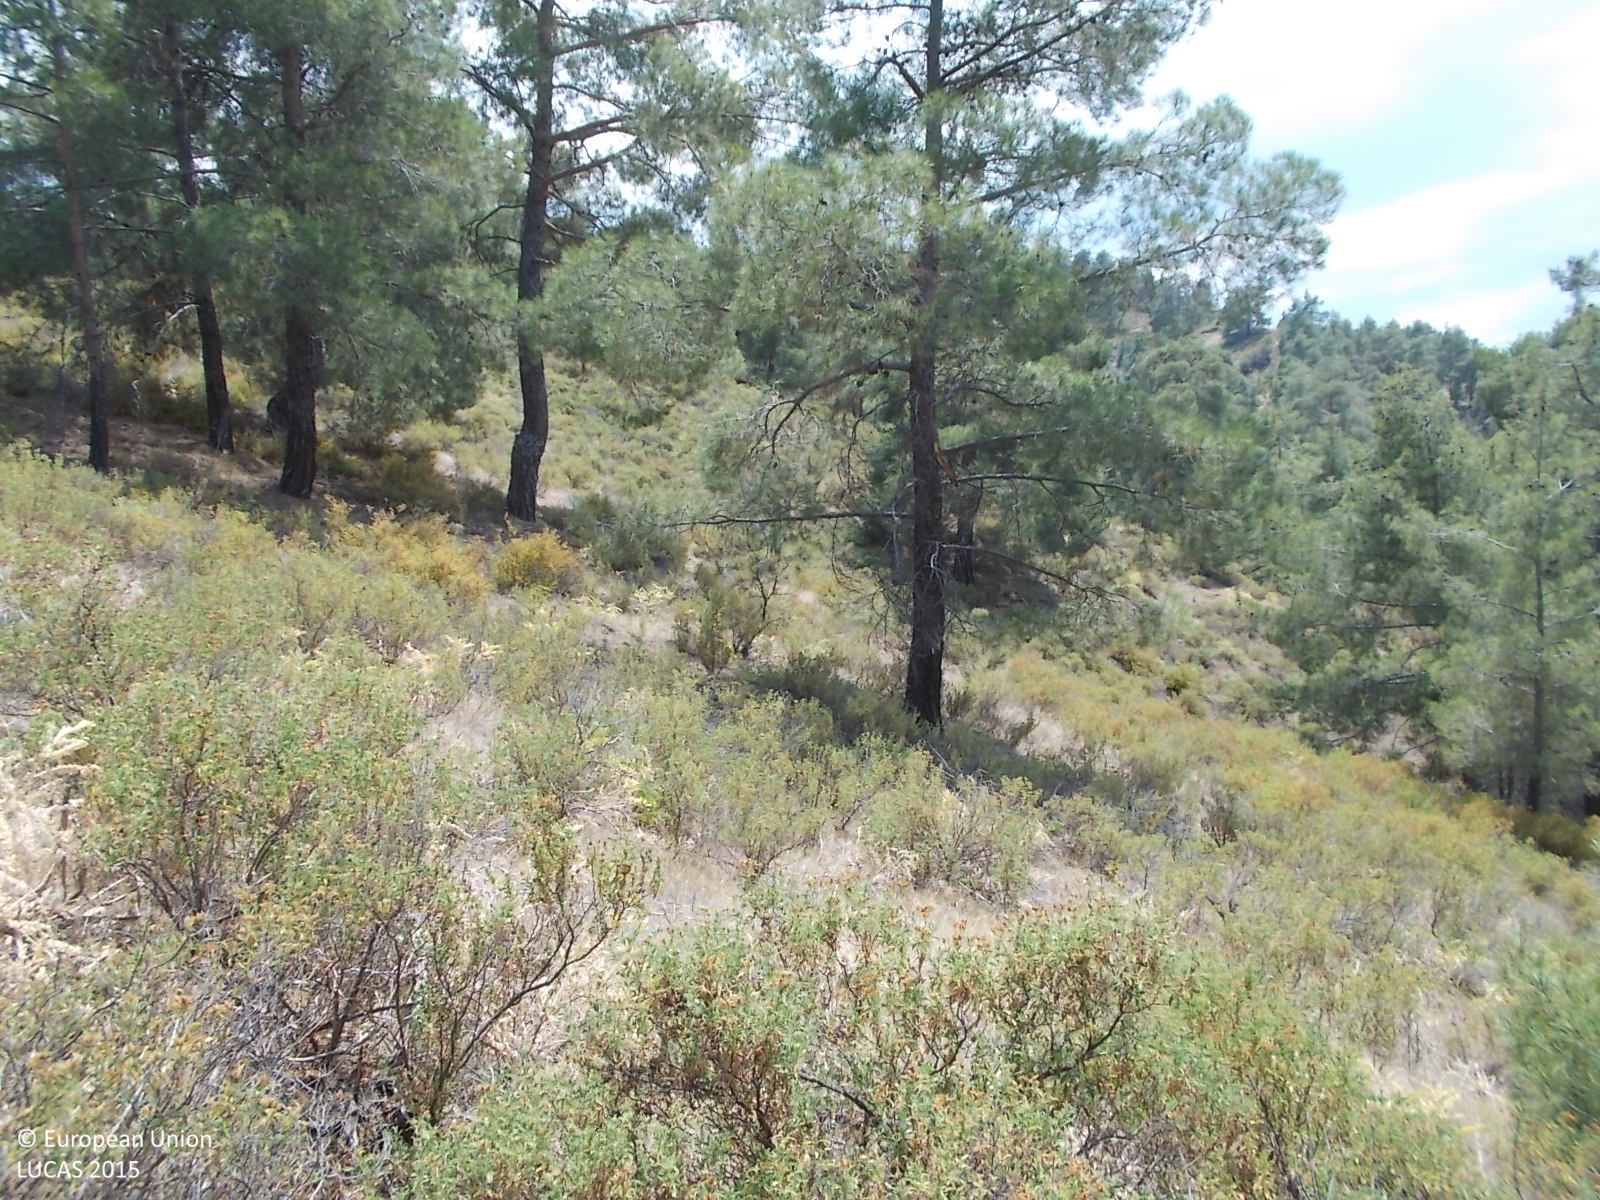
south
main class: Woodland
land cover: Pine dominated coniferous woodland
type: coniferous forest of the mediterranean region
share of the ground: 10 - 25 %
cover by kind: shrubs 55 %, unconsolidated bare surface 25 %, coniferous forest trees 20 %
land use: Forestry
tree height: > 5 m
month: June
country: CY
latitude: 34.9998
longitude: 32.9282
